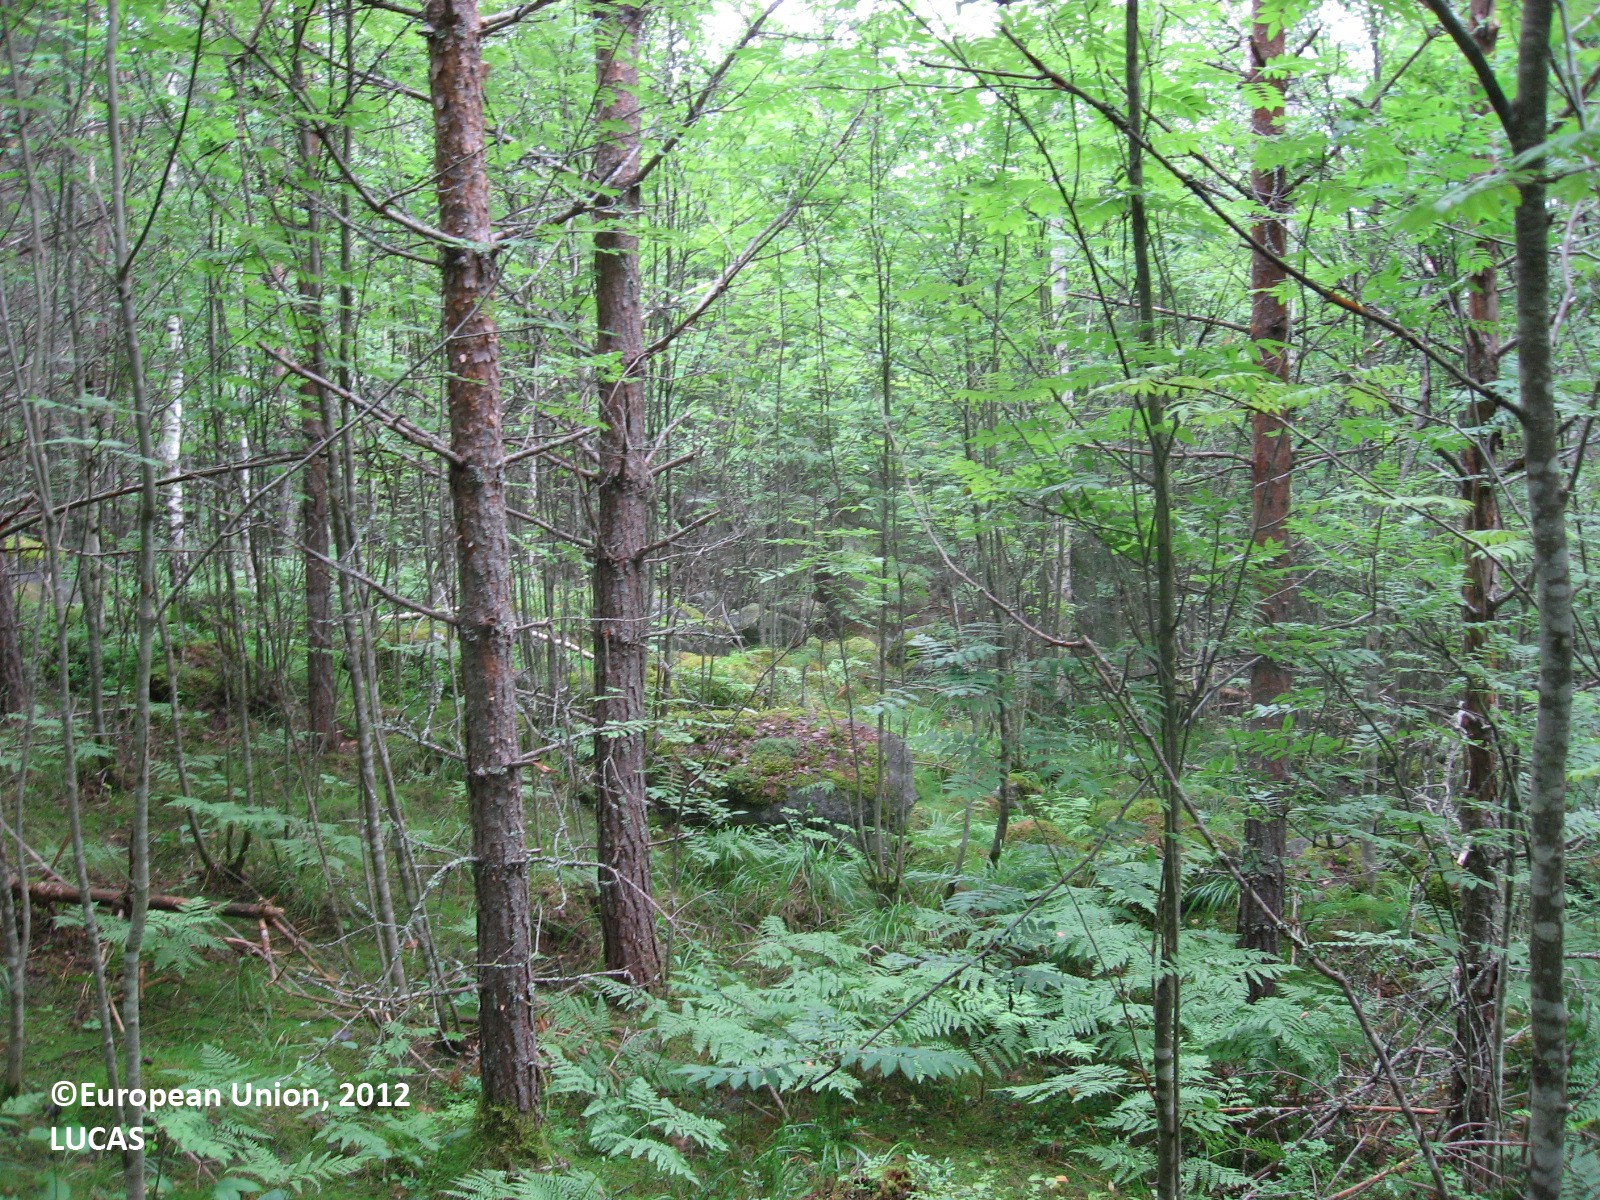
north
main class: Woodland
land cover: Pine dominated mixed woodland
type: boreal forest
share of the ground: > 75 %
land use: Forestry
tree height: > 5 m
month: July
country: FI
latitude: 61.0698
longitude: 25.7913
